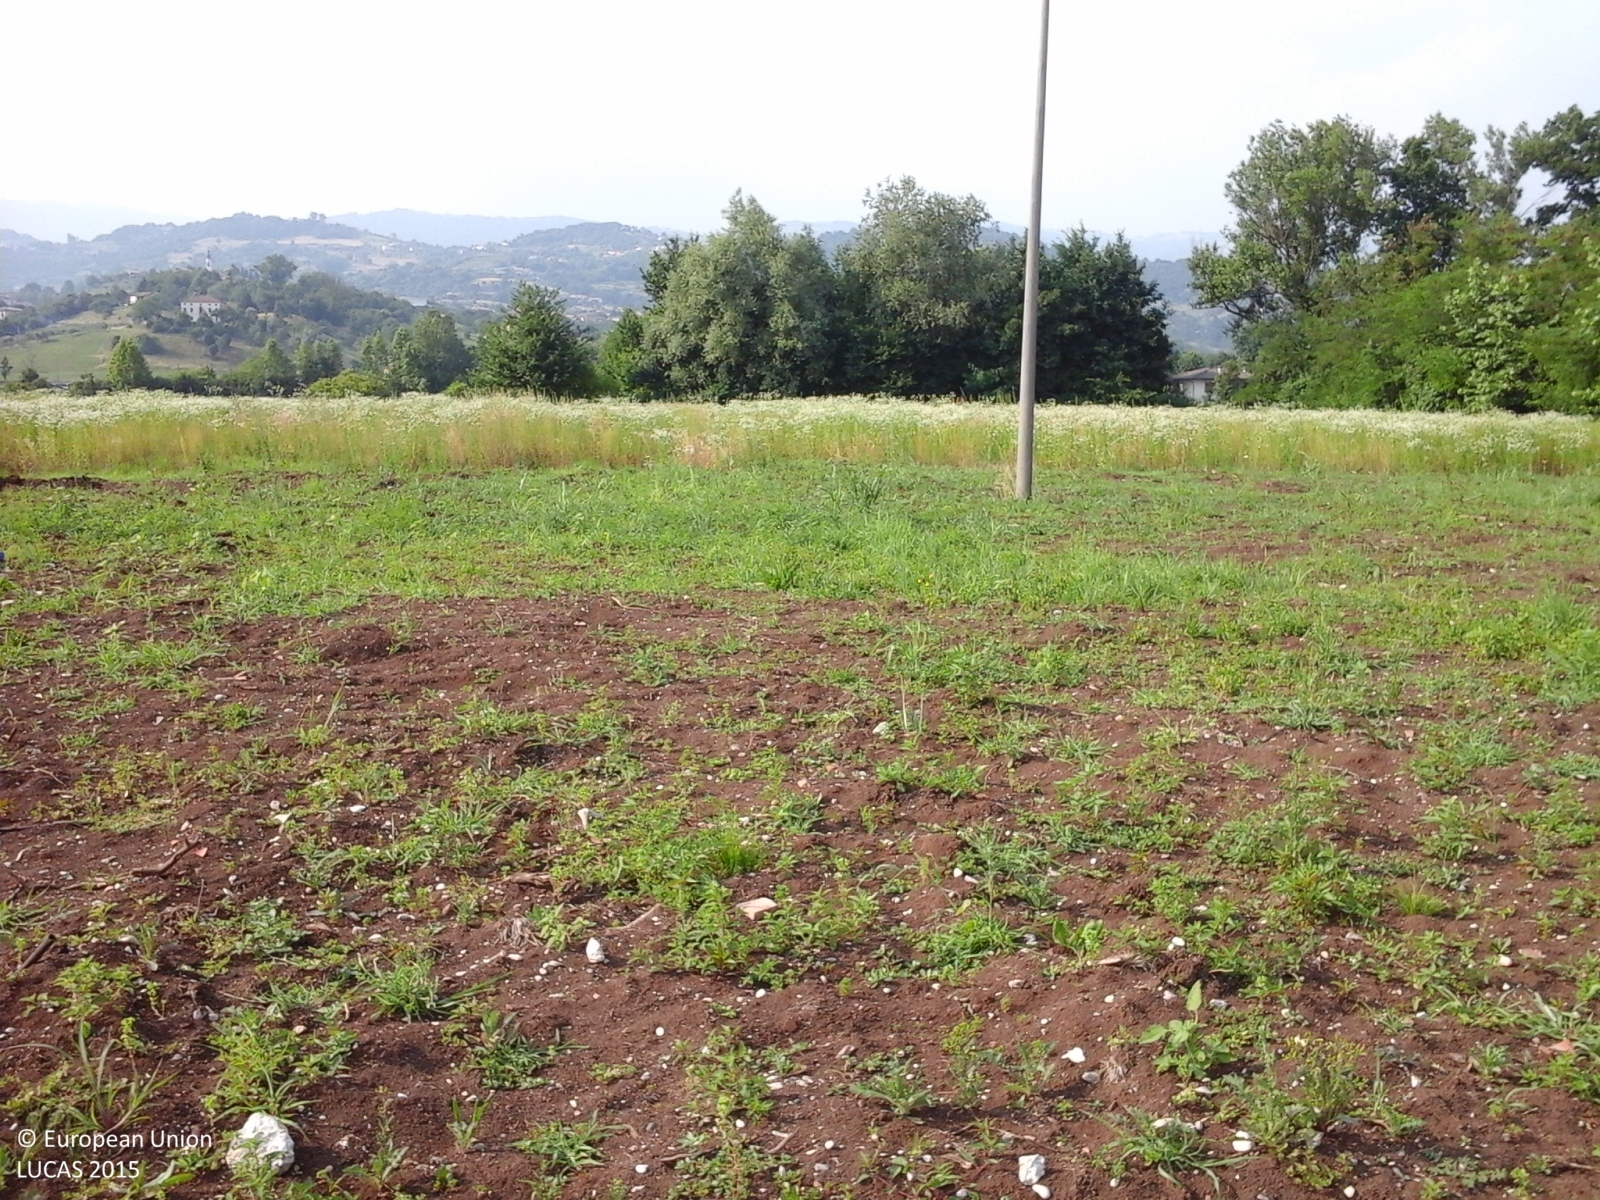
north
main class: Grassland
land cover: Spontaneously vegetated surfaces
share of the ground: 25 - 50 %
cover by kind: consolidated bare surface 60 %, herbaceous plants 40 %
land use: Fallow land
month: June
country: IT
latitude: 45.7261
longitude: 11.6294
